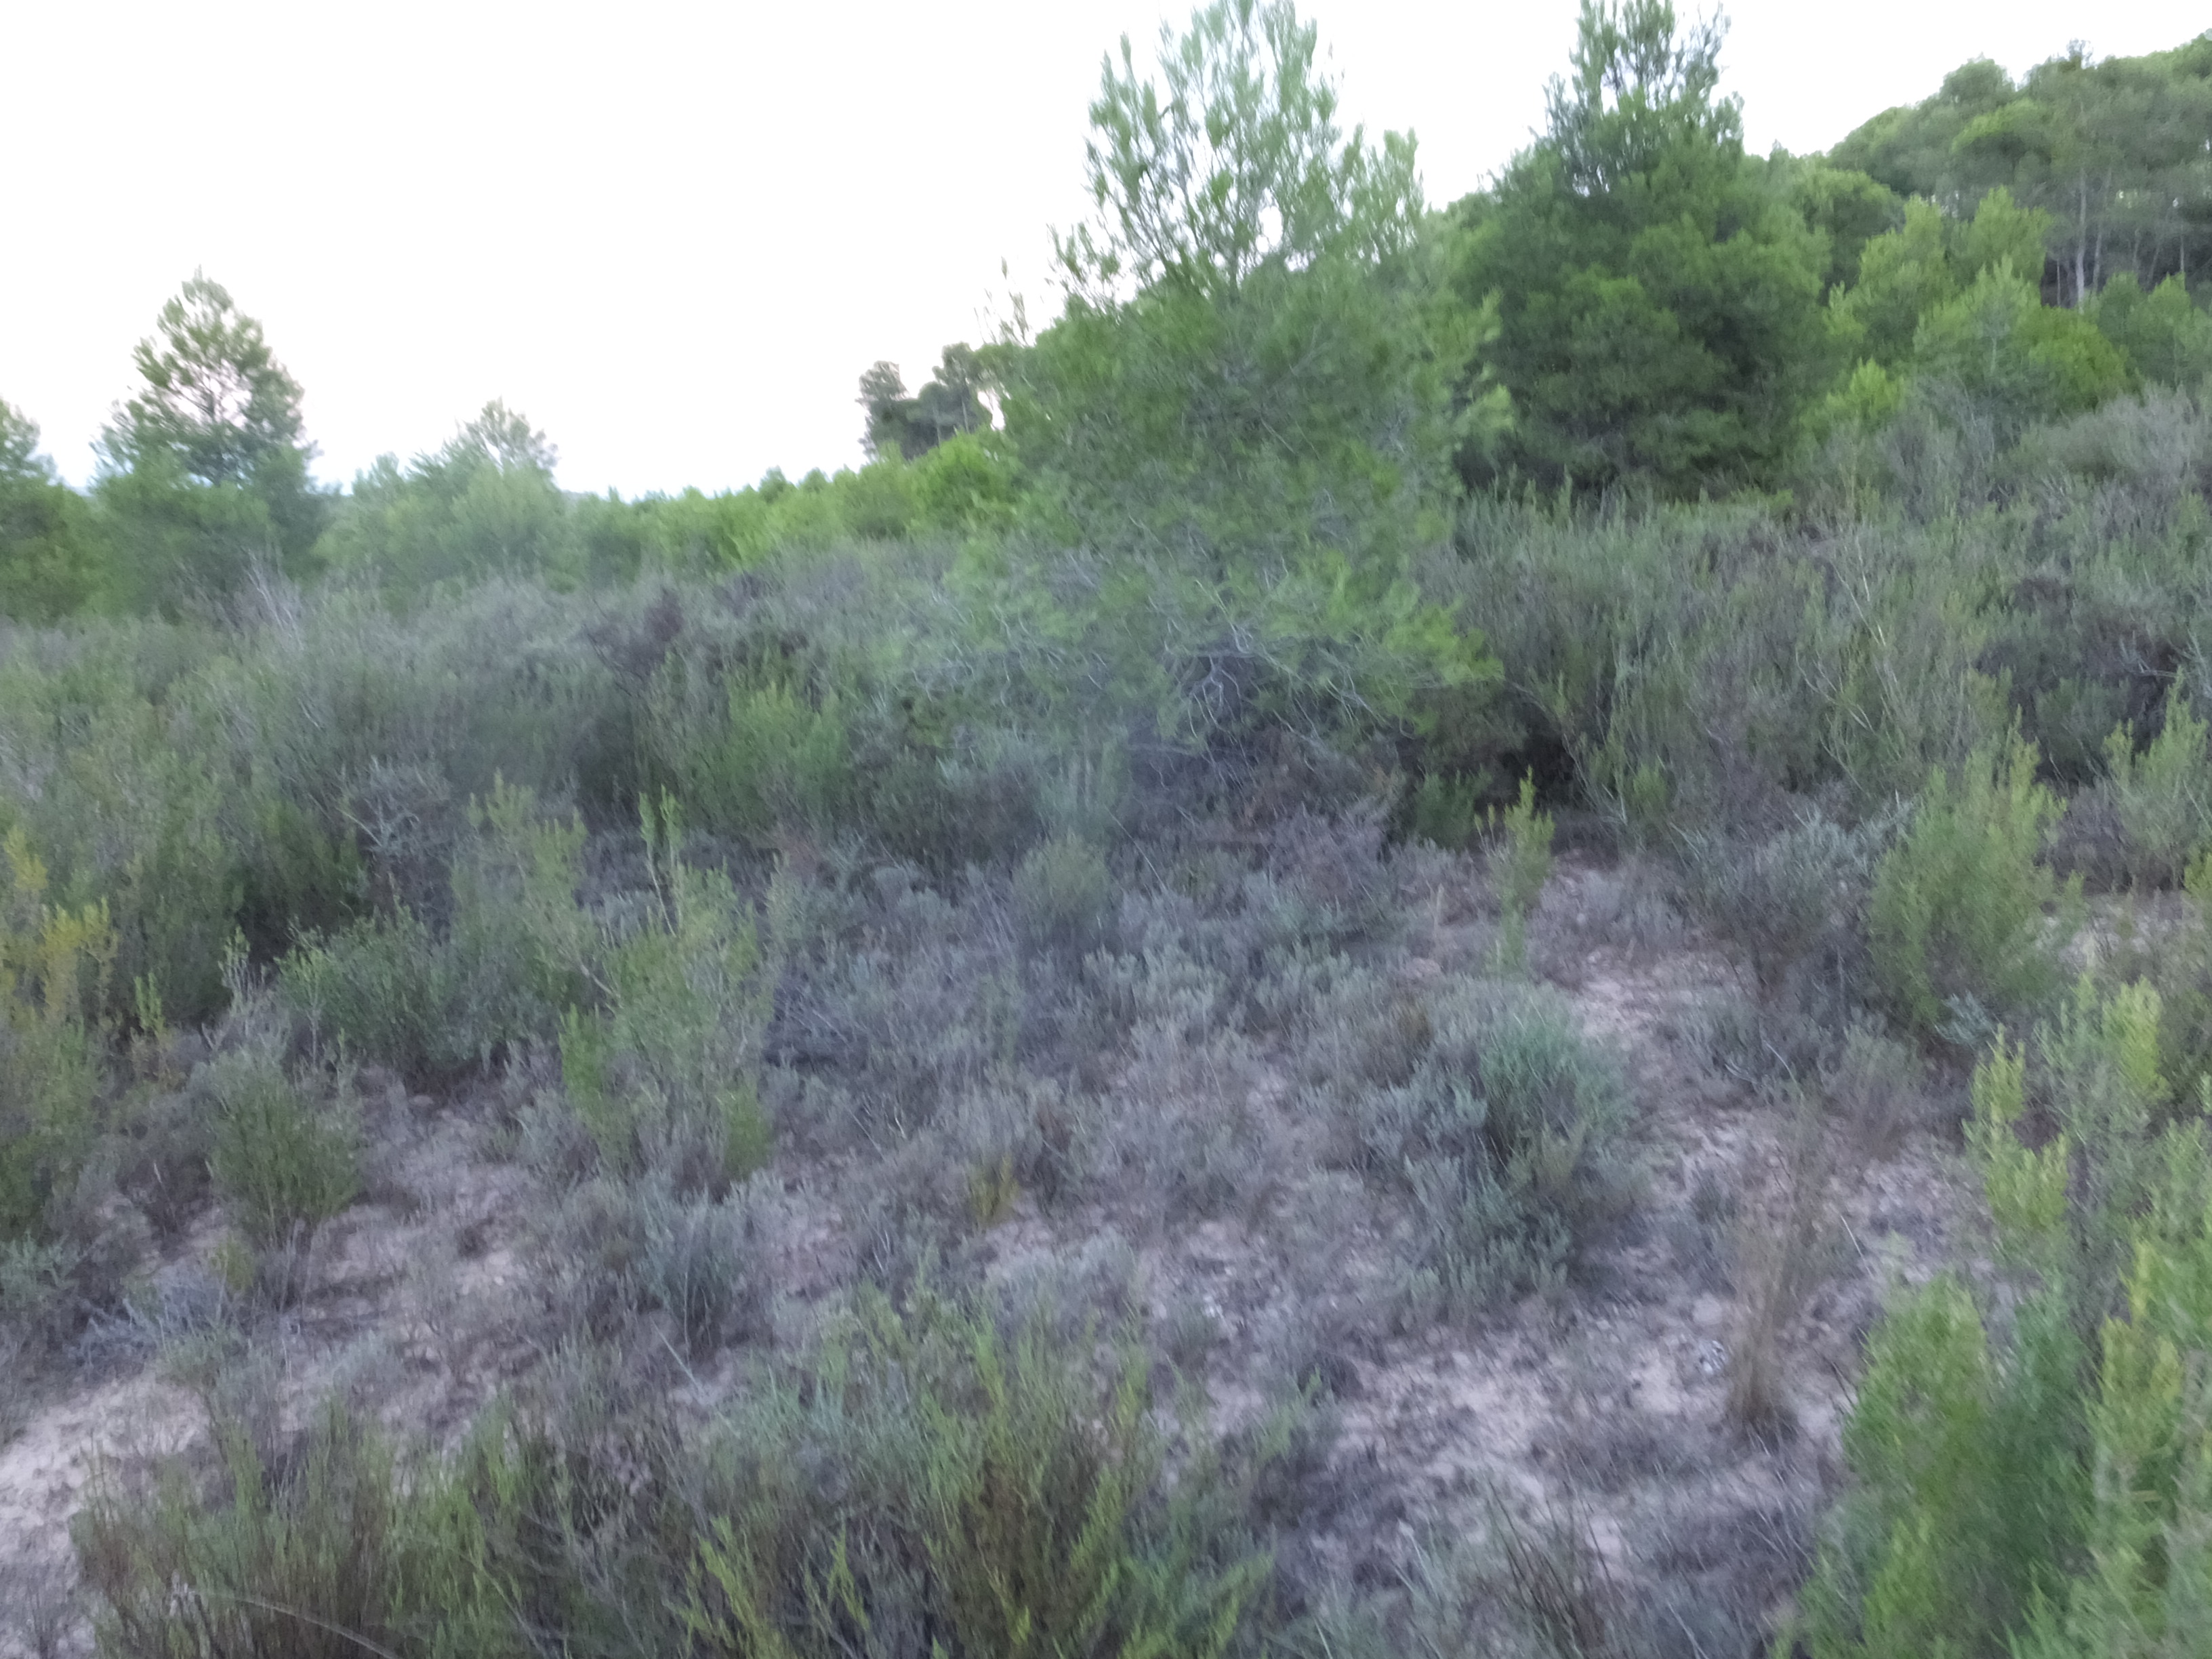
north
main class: Shrubland
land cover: Shrubland with sparse tree cover
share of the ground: > 75 %
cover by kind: shrubs 75 %, herbaceous plants 20 %, coniferous forest trees 5 %
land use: Abandoned areas
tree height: < 5 m
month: August
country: ES
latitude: 41.3568
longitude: 0.1740
